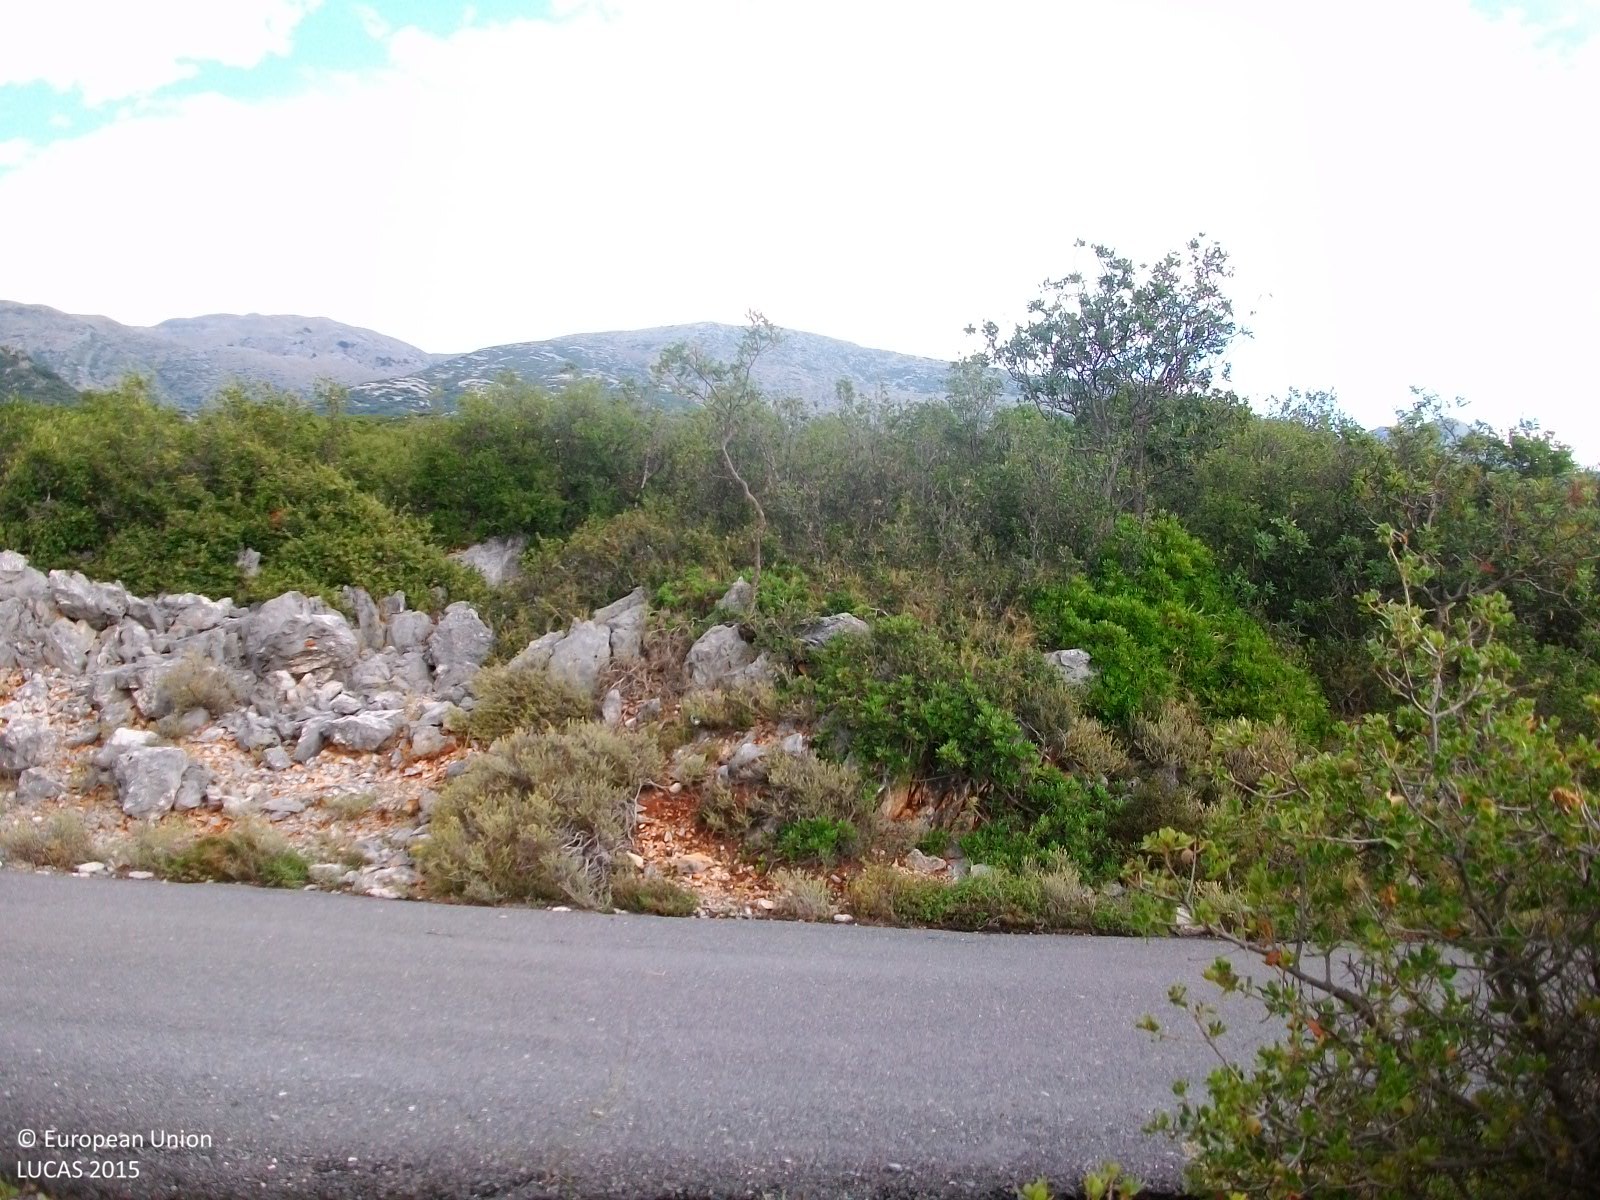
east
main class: Shrubland
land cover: Shrubland without tree cover
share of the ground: > 75 %
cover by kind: shrubs 90 %, unconsolidated bare surface 10 %
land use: Semi-natural and natural areas not in use
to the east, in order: Shrubland without tree cover; Paved roads, cycling and walking lanes; Shrubland without tree cover
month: August
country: GR
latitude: 36.9344
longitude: 22.2468
